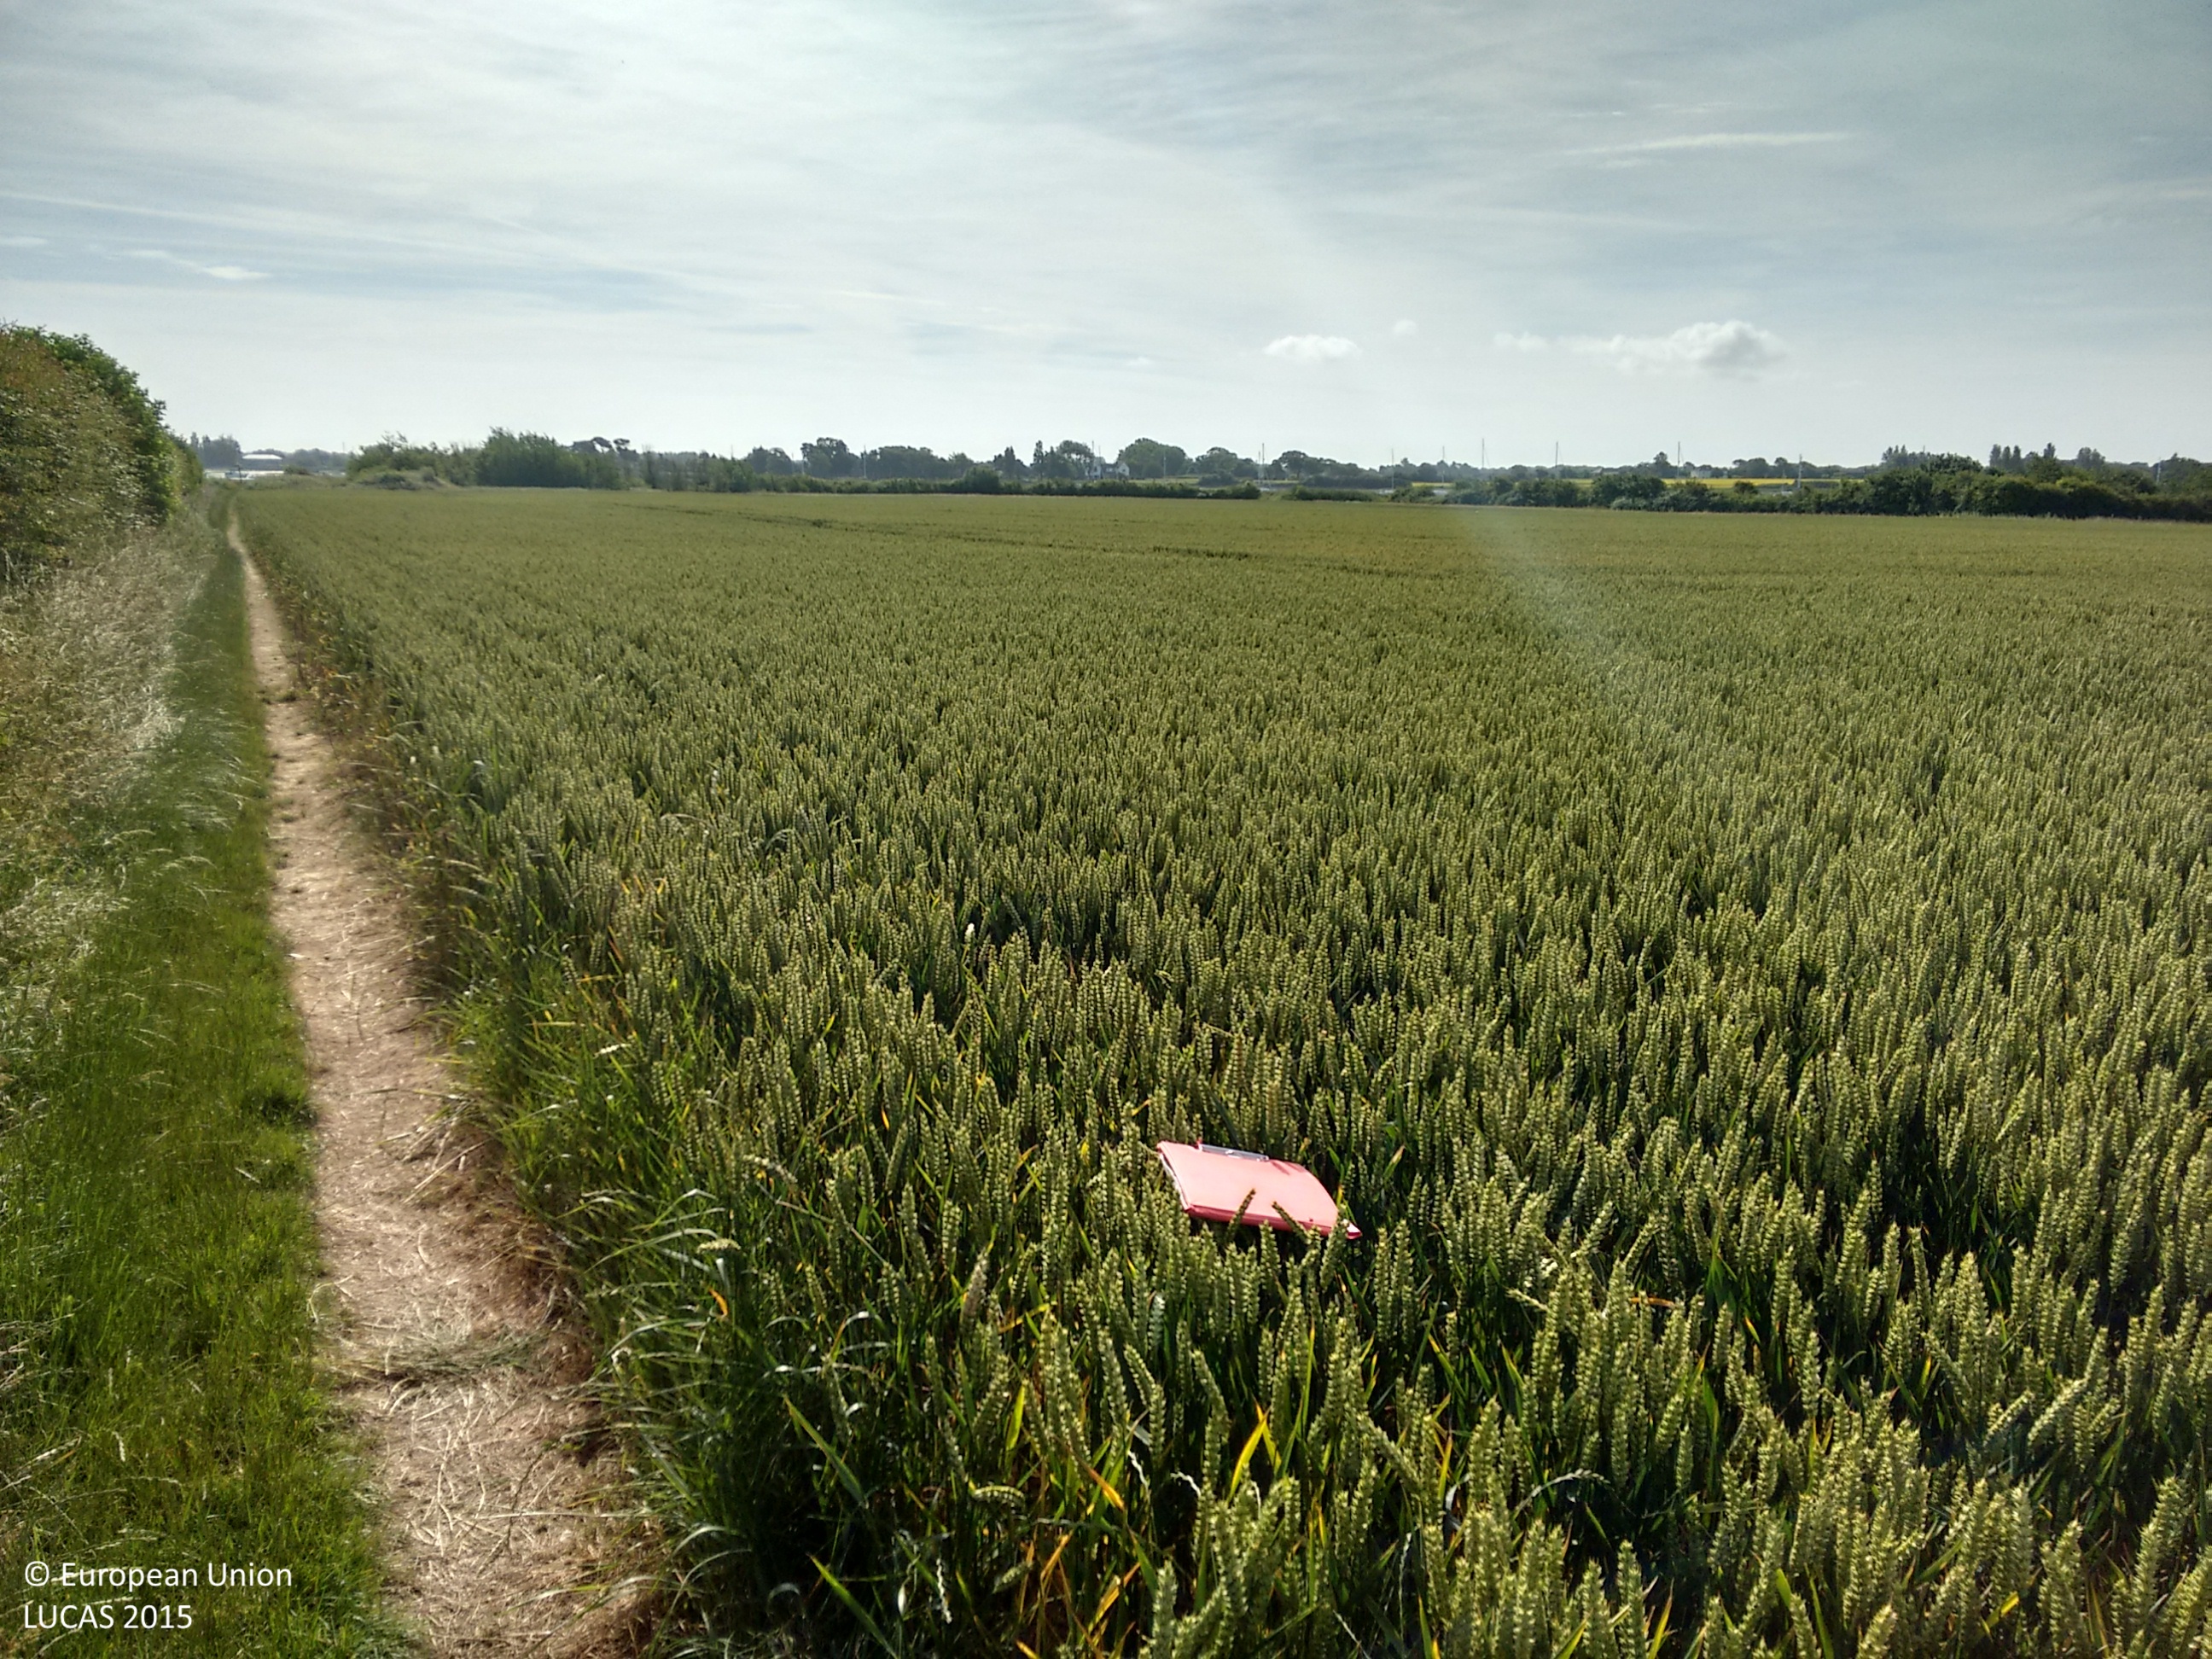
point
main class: Cropland
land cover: Common wheat
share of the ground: 50 - 75 %
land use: Agriculture (excluding fallow land and kitchen gardens)
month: June
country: GB
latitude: 50.8239
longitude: -0.8742
